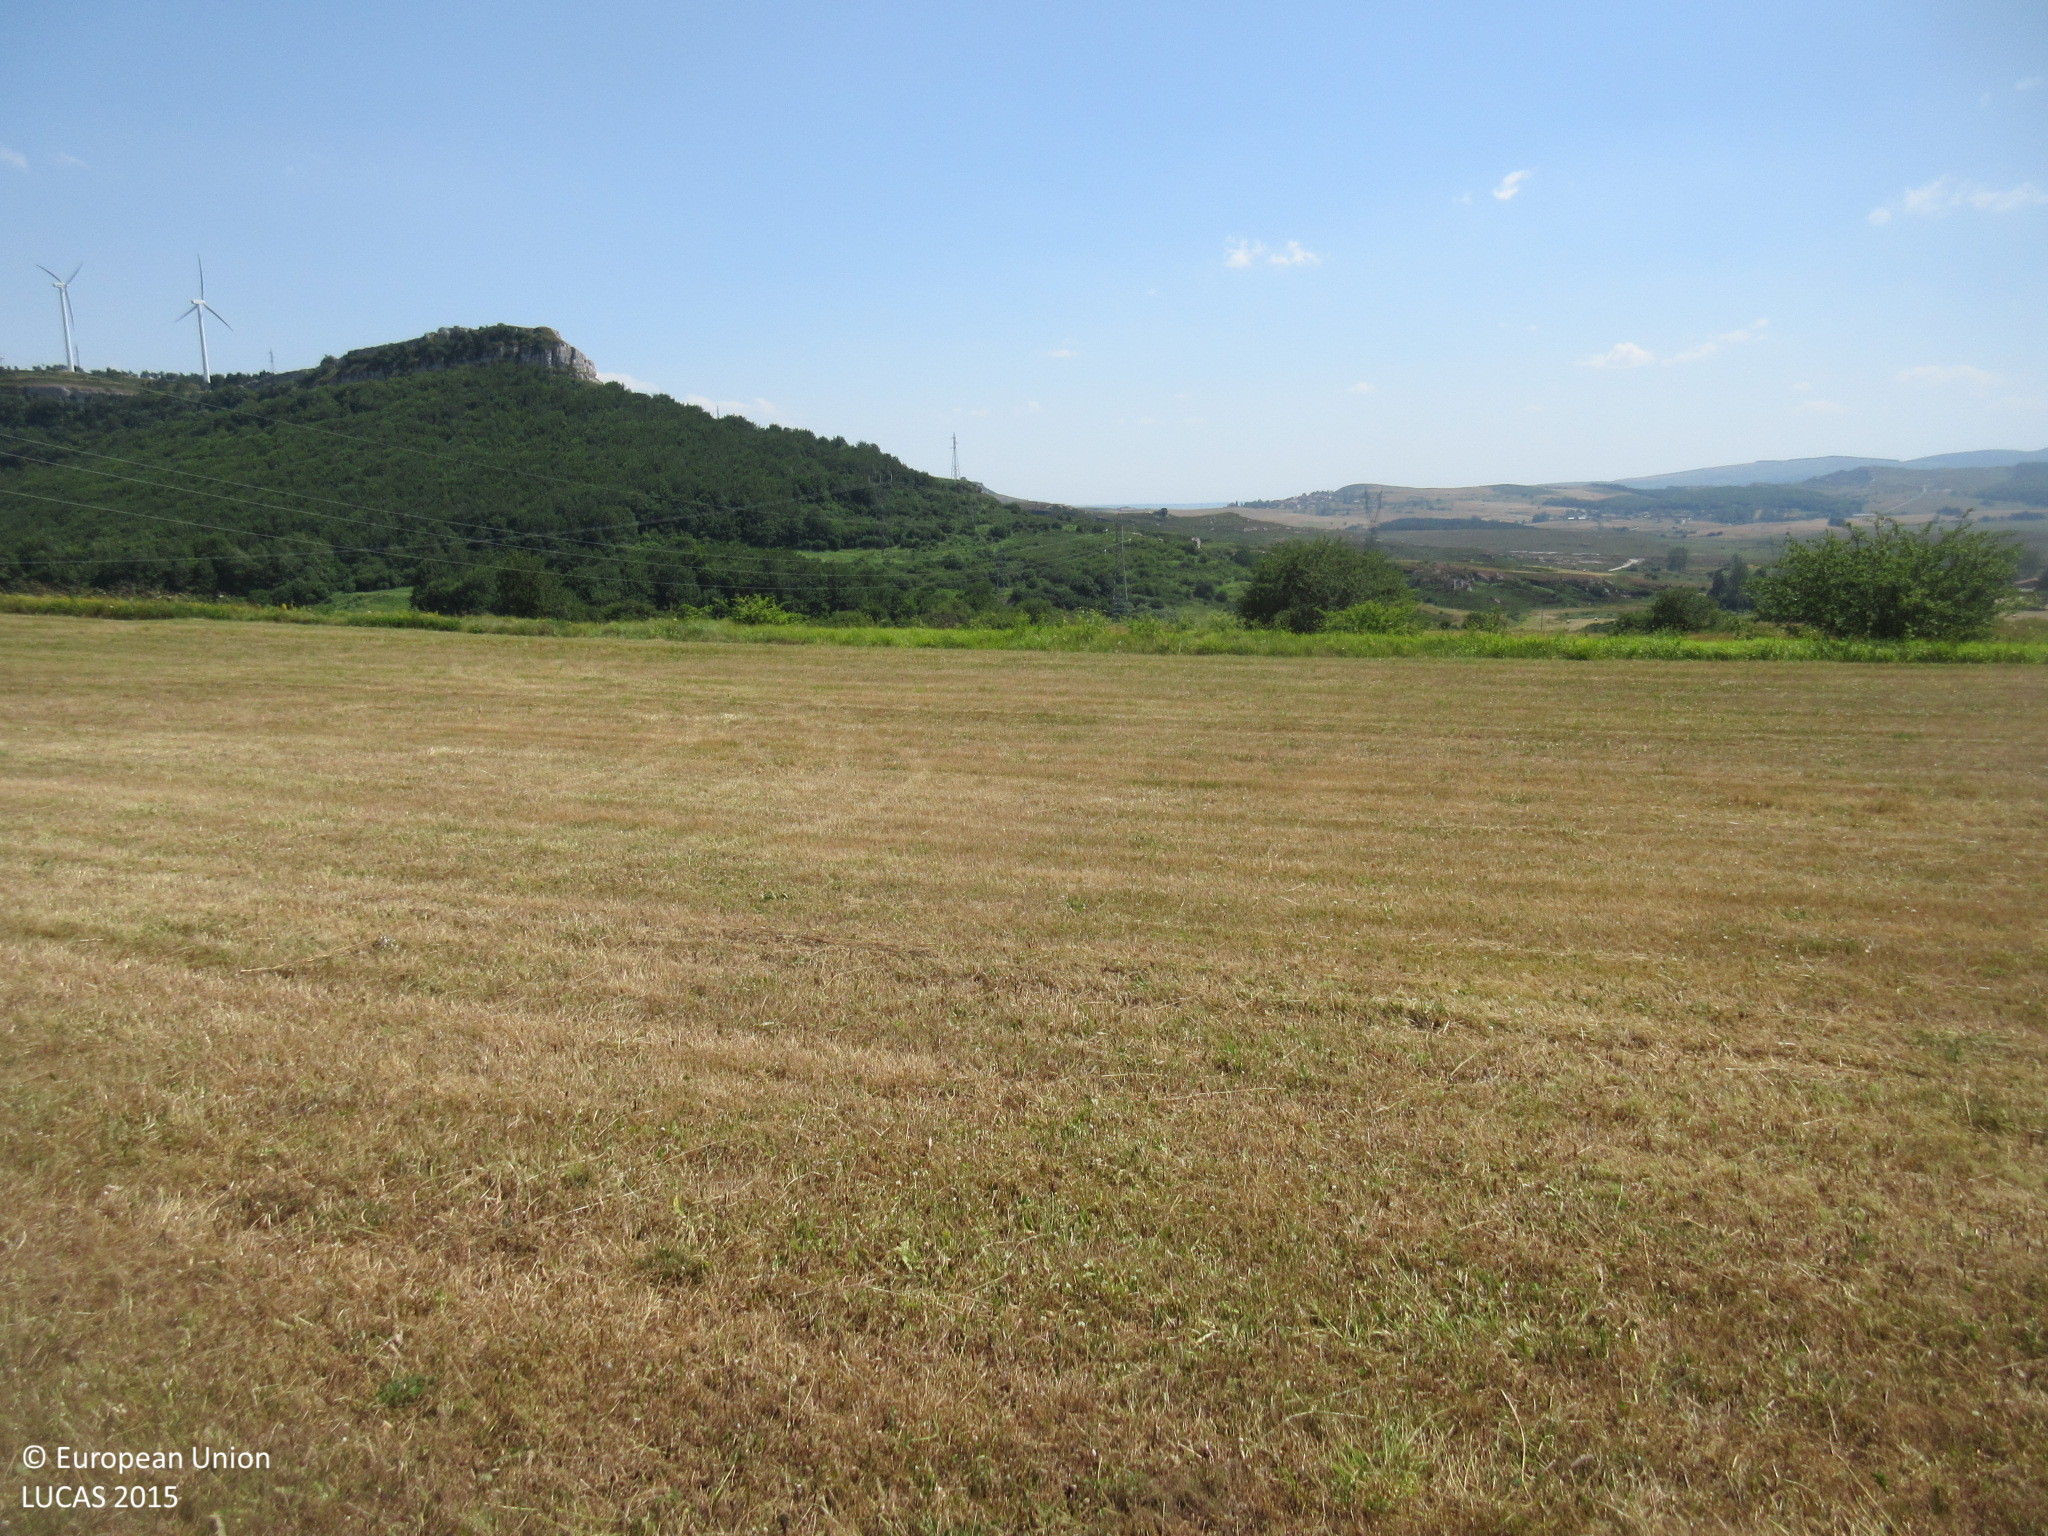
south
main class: Grassland
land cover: Grassland without tree/shrub cover
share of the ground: > 75 %
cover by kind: herbaceous plants 100 %
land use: Agriculture (excluding fallow land and kitchen gardens)
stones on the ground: 25 - 50 %
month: July
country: ES
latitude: 42.9725
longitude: -3.8887
